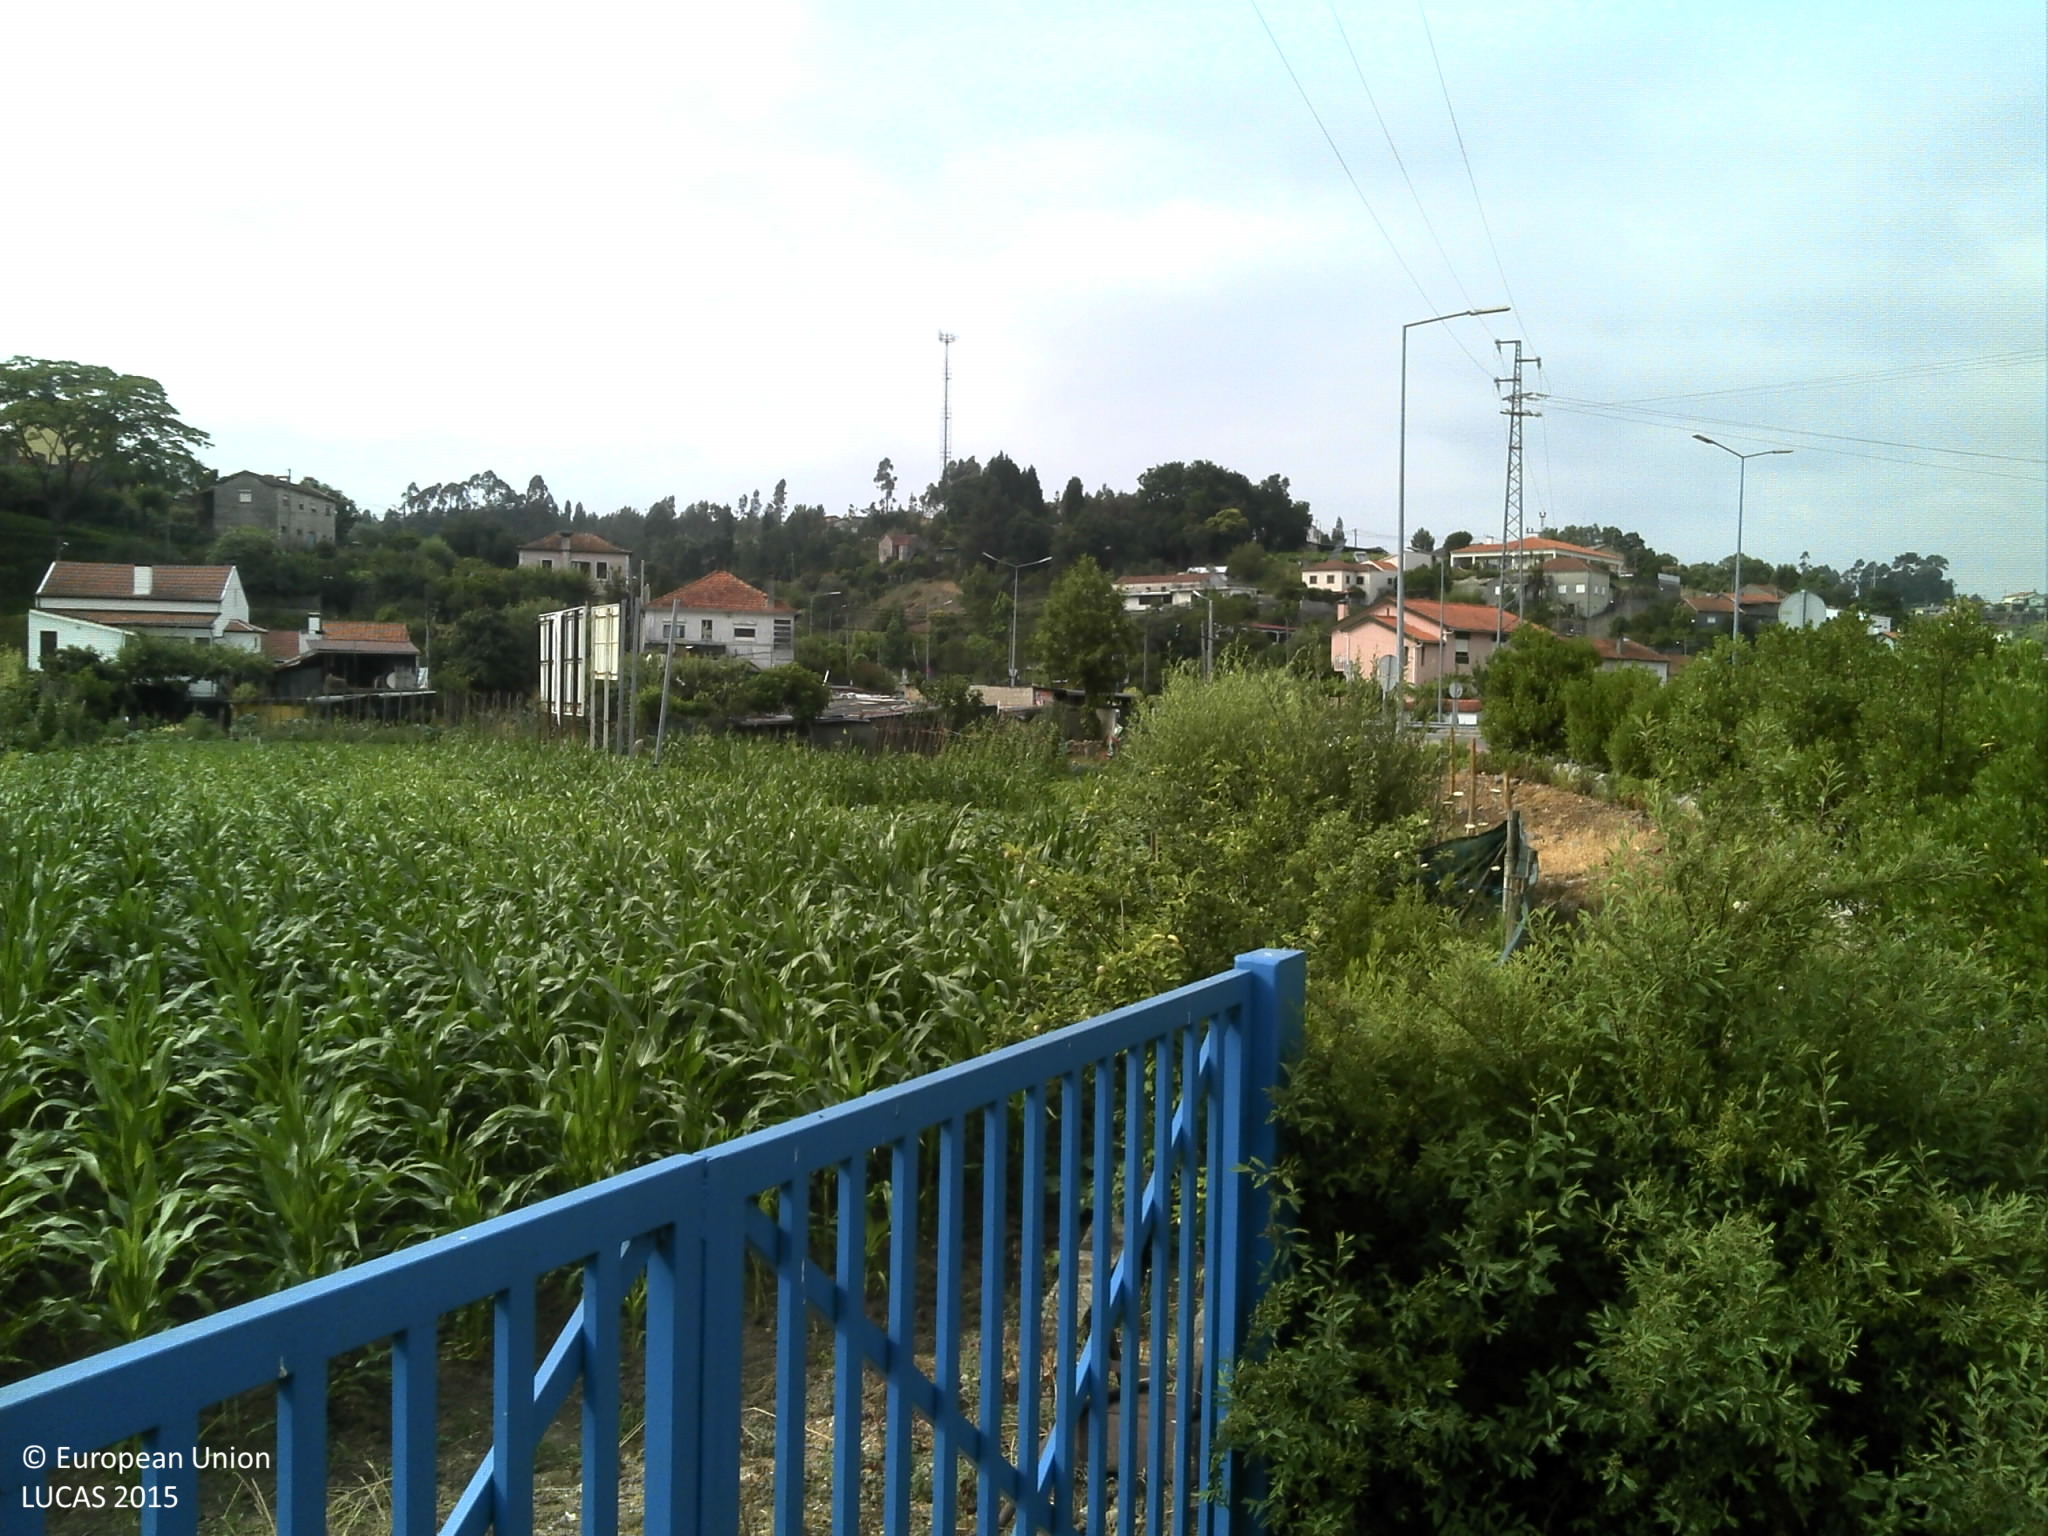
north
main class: Grassland
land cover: Spontaneously vegetated surfaces
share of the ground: > 75 %
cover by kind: herbaceous plants 80 %, unconsolidated bare surface 20 %
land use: Fallow land
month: June
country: PT
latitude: 40.5746
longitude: -8.4355
